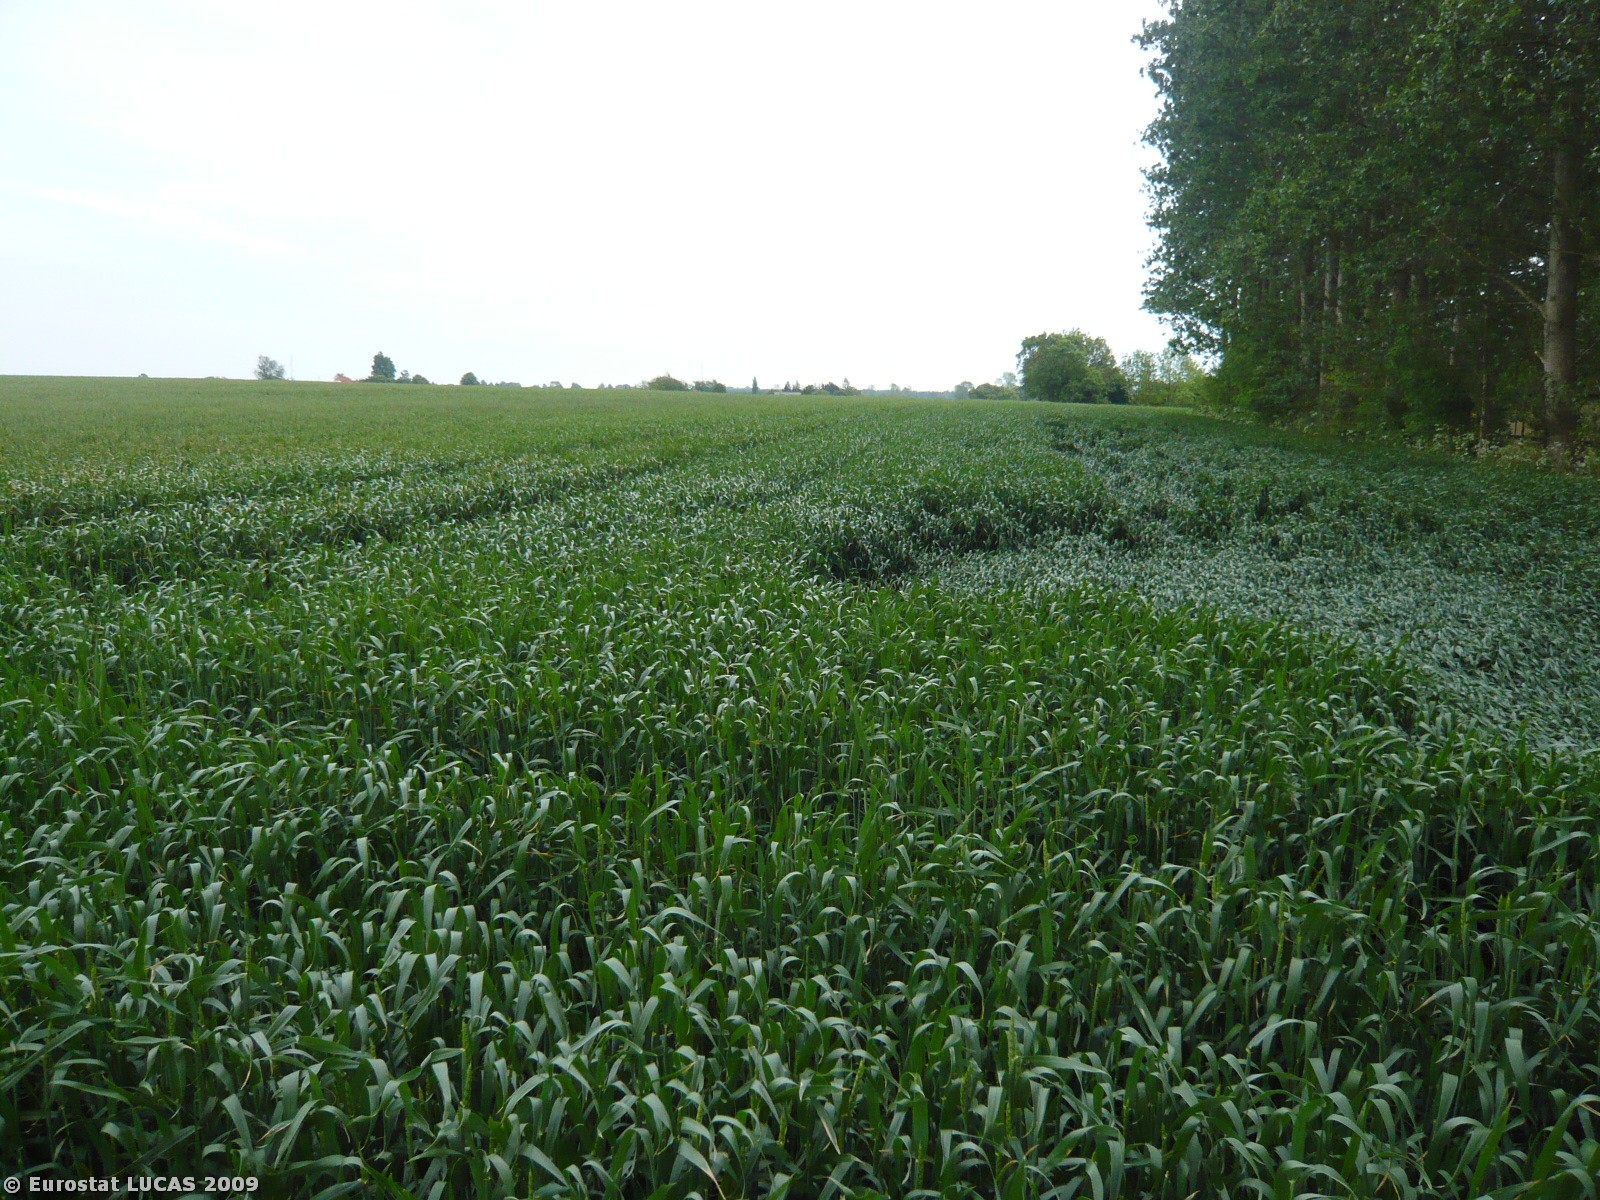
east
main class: Cropland
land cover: Common wheat
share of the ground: > 75 %
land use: Agriculture (excluding fallow land and kitchen gardens)
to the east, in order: Common wheat
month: June
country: DK
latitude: 54.7168
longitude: 11.9393
